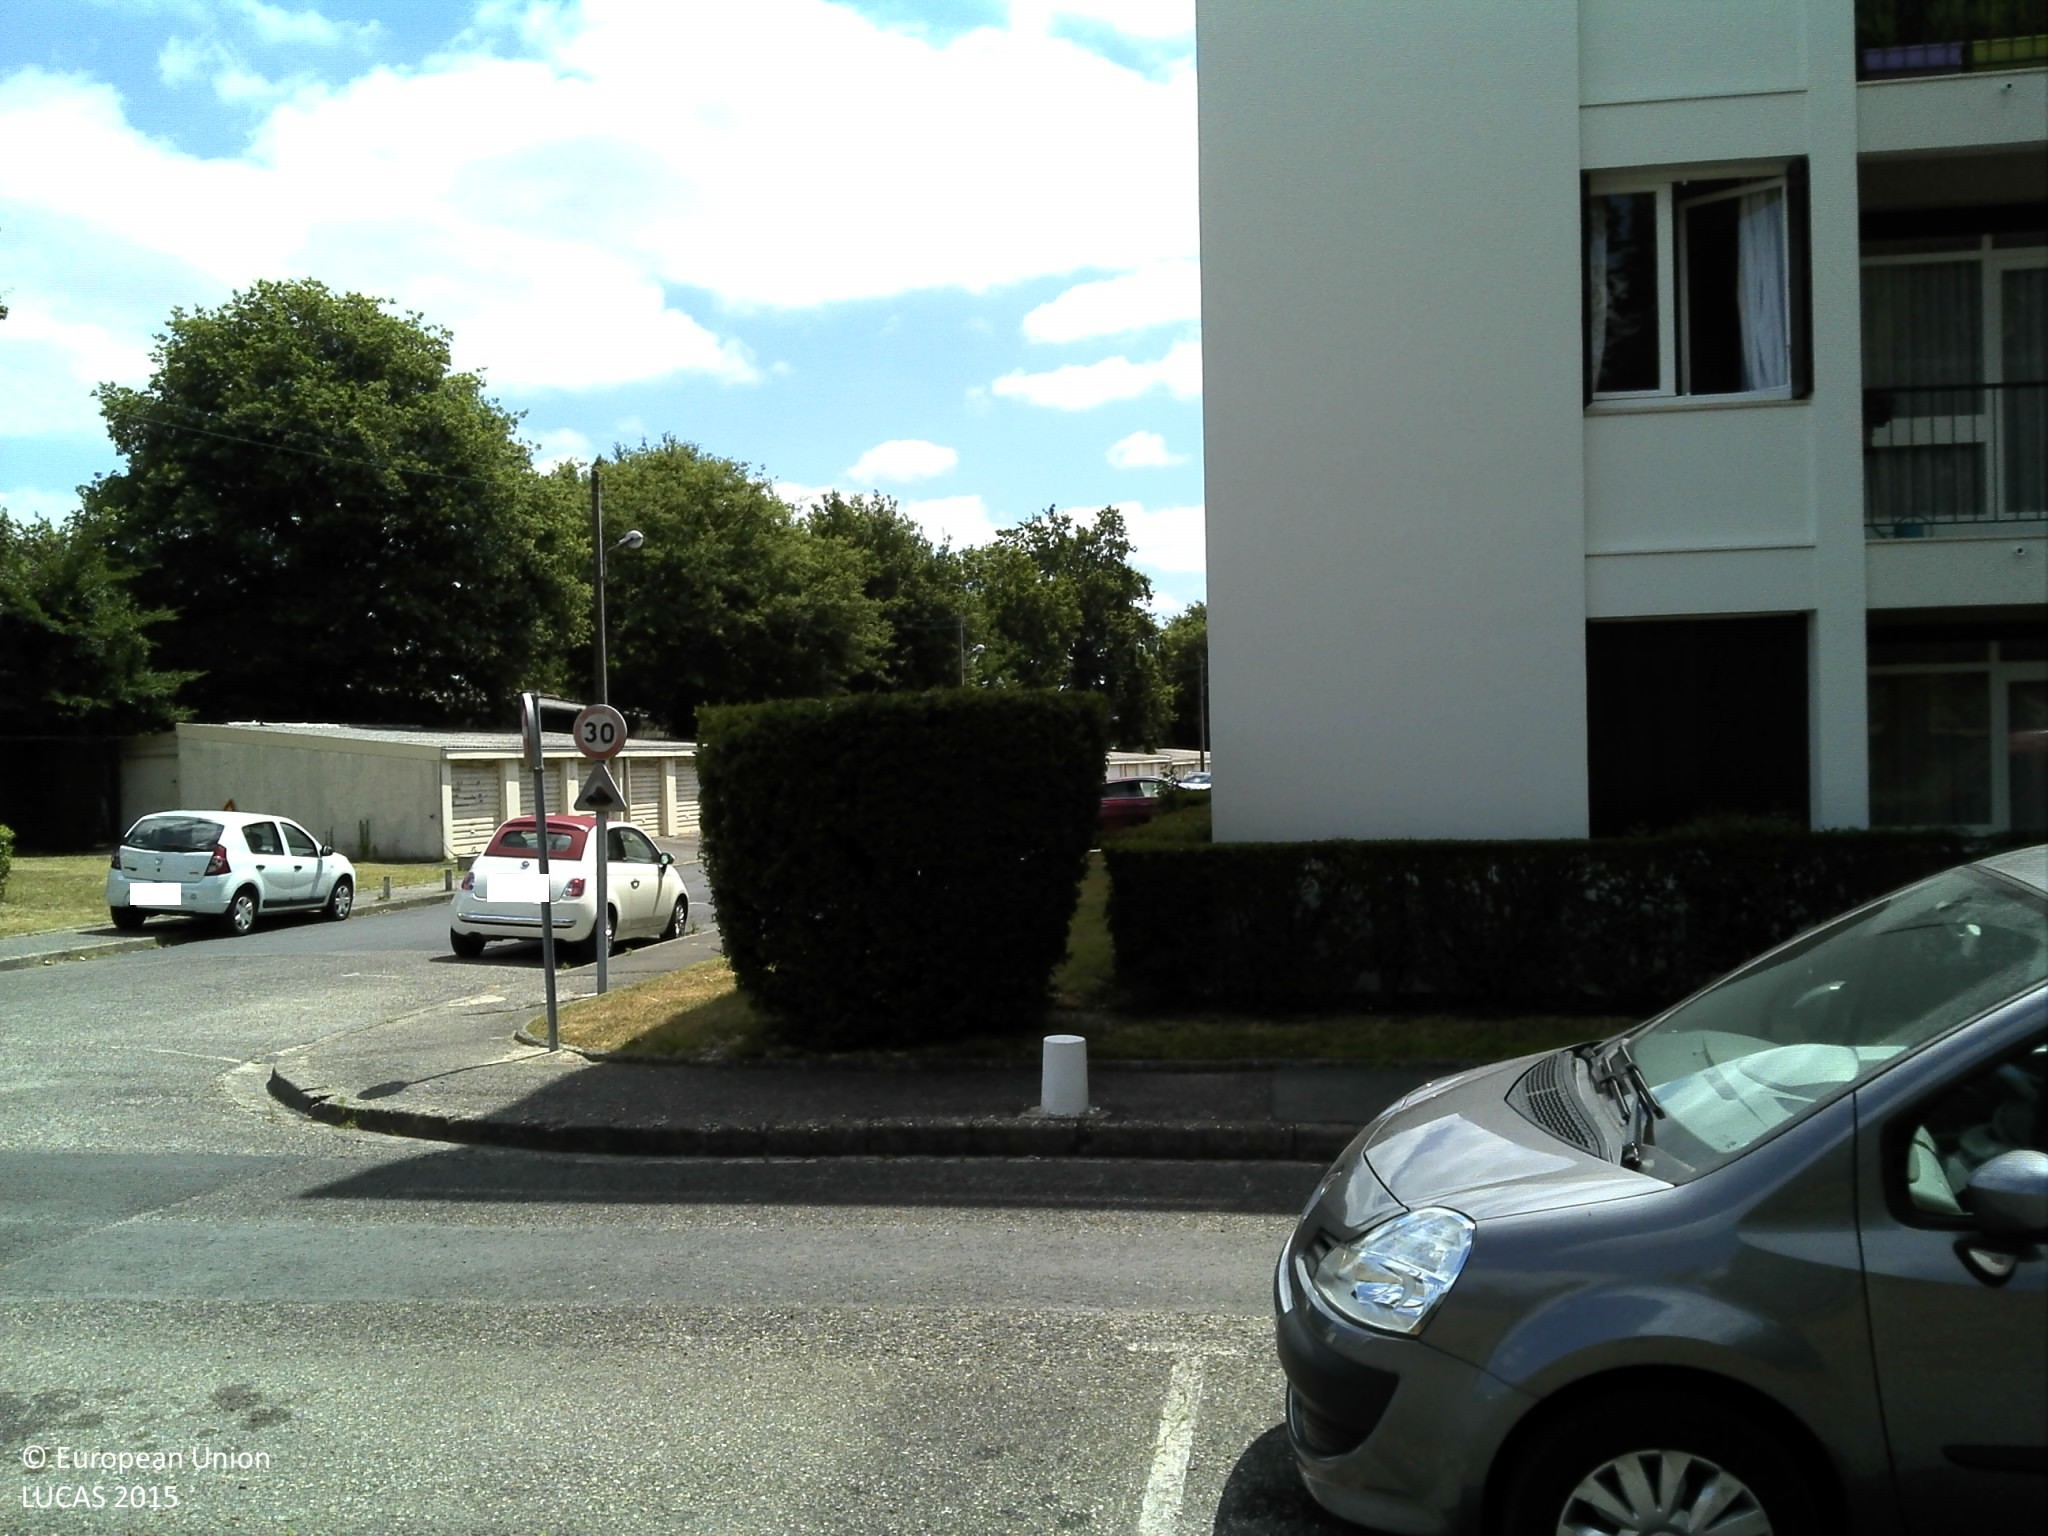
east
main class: Grassland
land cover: Grassland with sparse tree/shrub cover
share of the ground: > 75 %
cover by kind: herbaceous plants 95 %, broadleaved forest trees 5 %
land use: Amenities, museums, leisure
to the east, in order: Grassland with sparse tree/shrub cover; Artificial constructions in urban areas
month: July
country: FR
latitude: 44.8565
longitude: -0.6362
